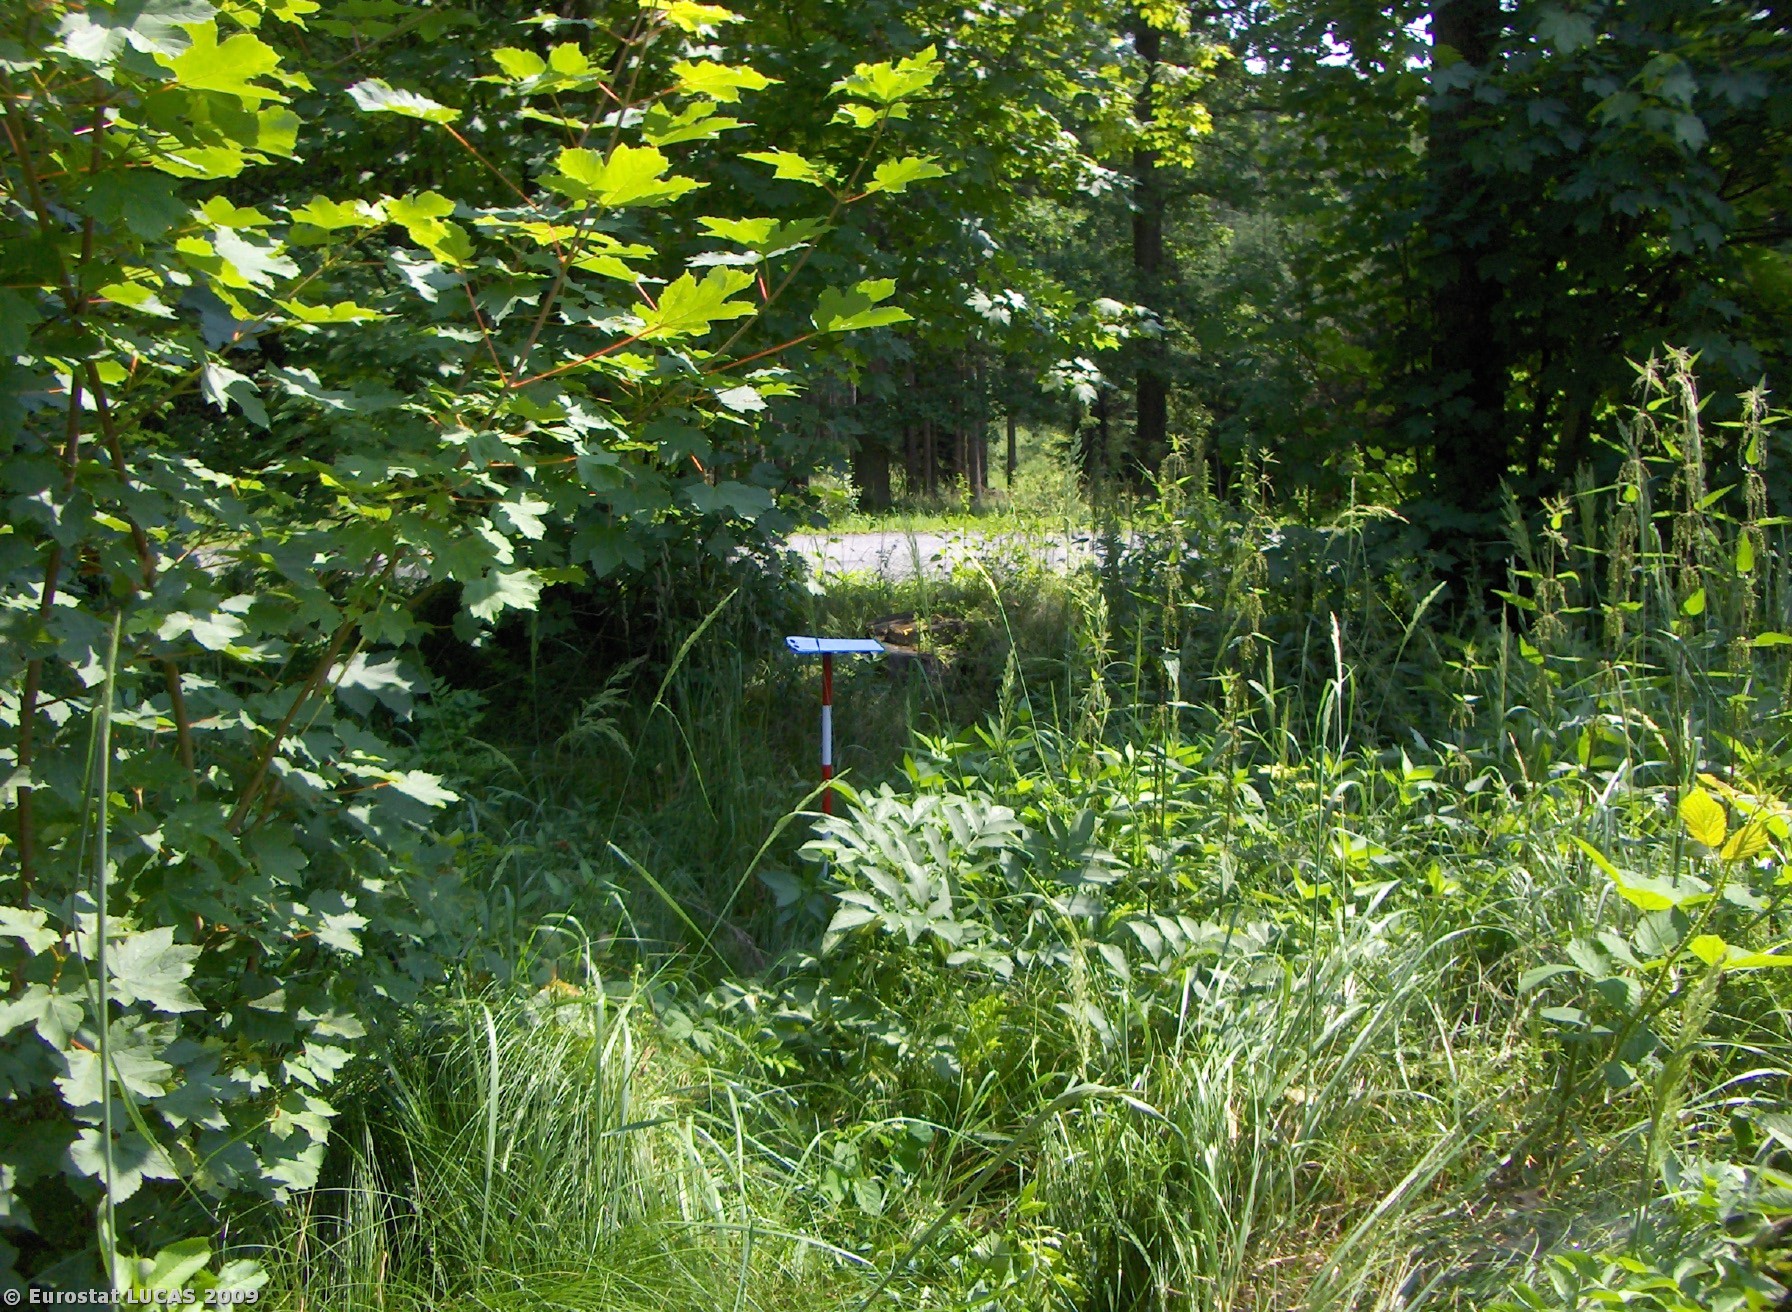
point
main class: Woodland
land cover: Broadleaved woodland
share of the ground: > 75 %
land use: Forestry
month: July
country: CZ
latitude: 49.5457
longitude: 13.1925
